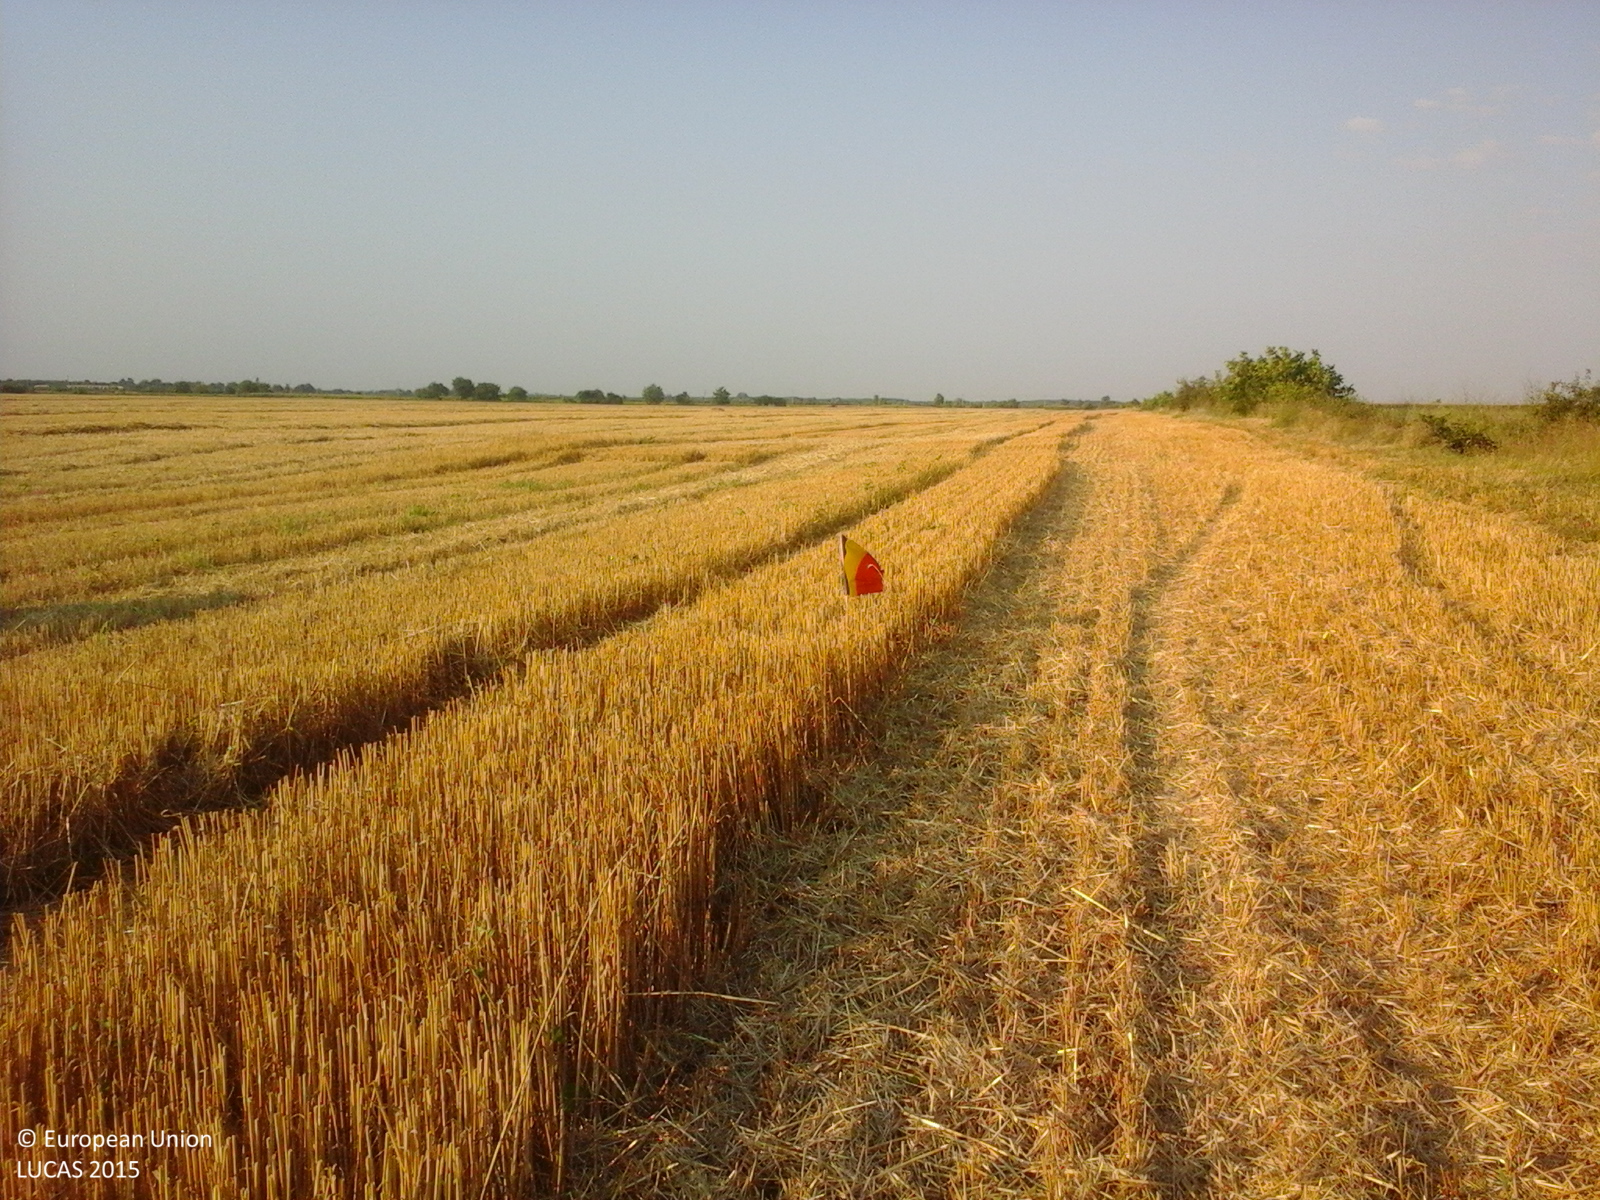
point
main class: Cropland
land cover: Durum wheat
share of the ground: 25 - 50 %
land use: Agriculture (excluding fallow land and kitchen gardens)
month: July
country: RO
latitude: 44.5888
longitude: 27.1254
